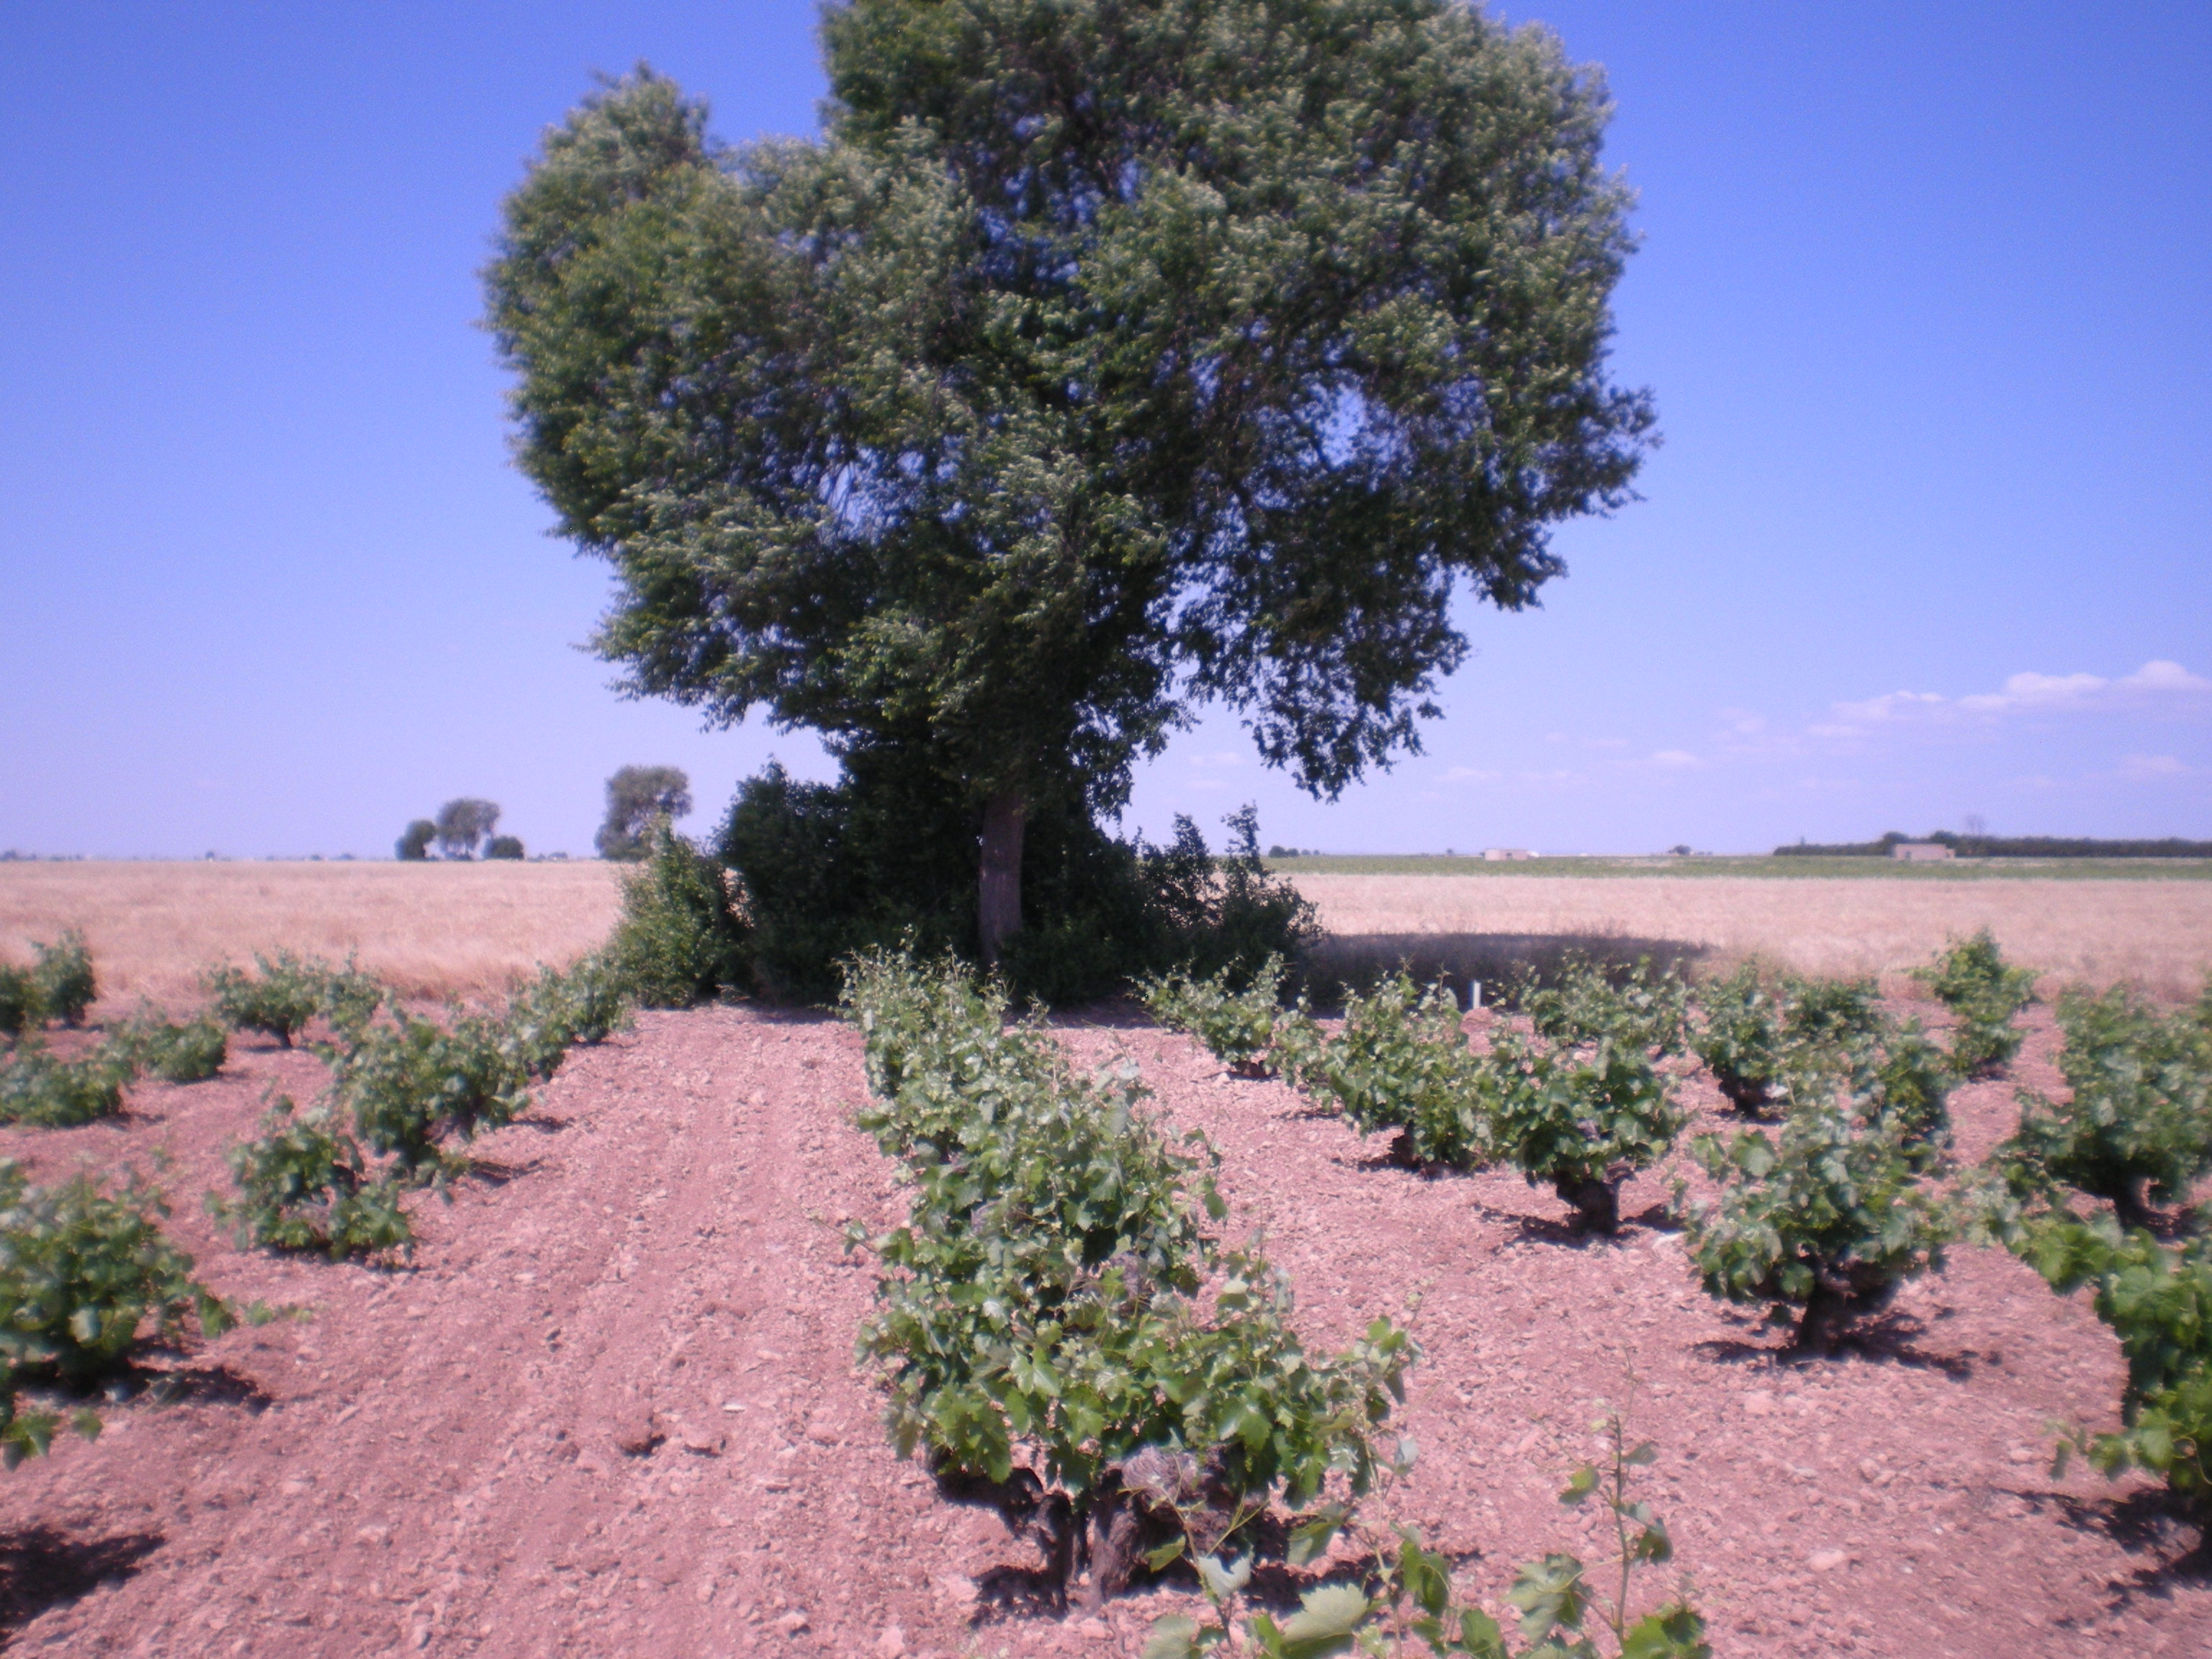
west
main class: Cropland
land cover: Vineyards
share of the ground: 10 - 25 %
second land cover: Other bare soil
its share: > 75 %
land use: Agriculture (excluding fallow land and kitchen gardens)
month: May
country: ES
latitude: 39.0933
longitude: -3.4864
